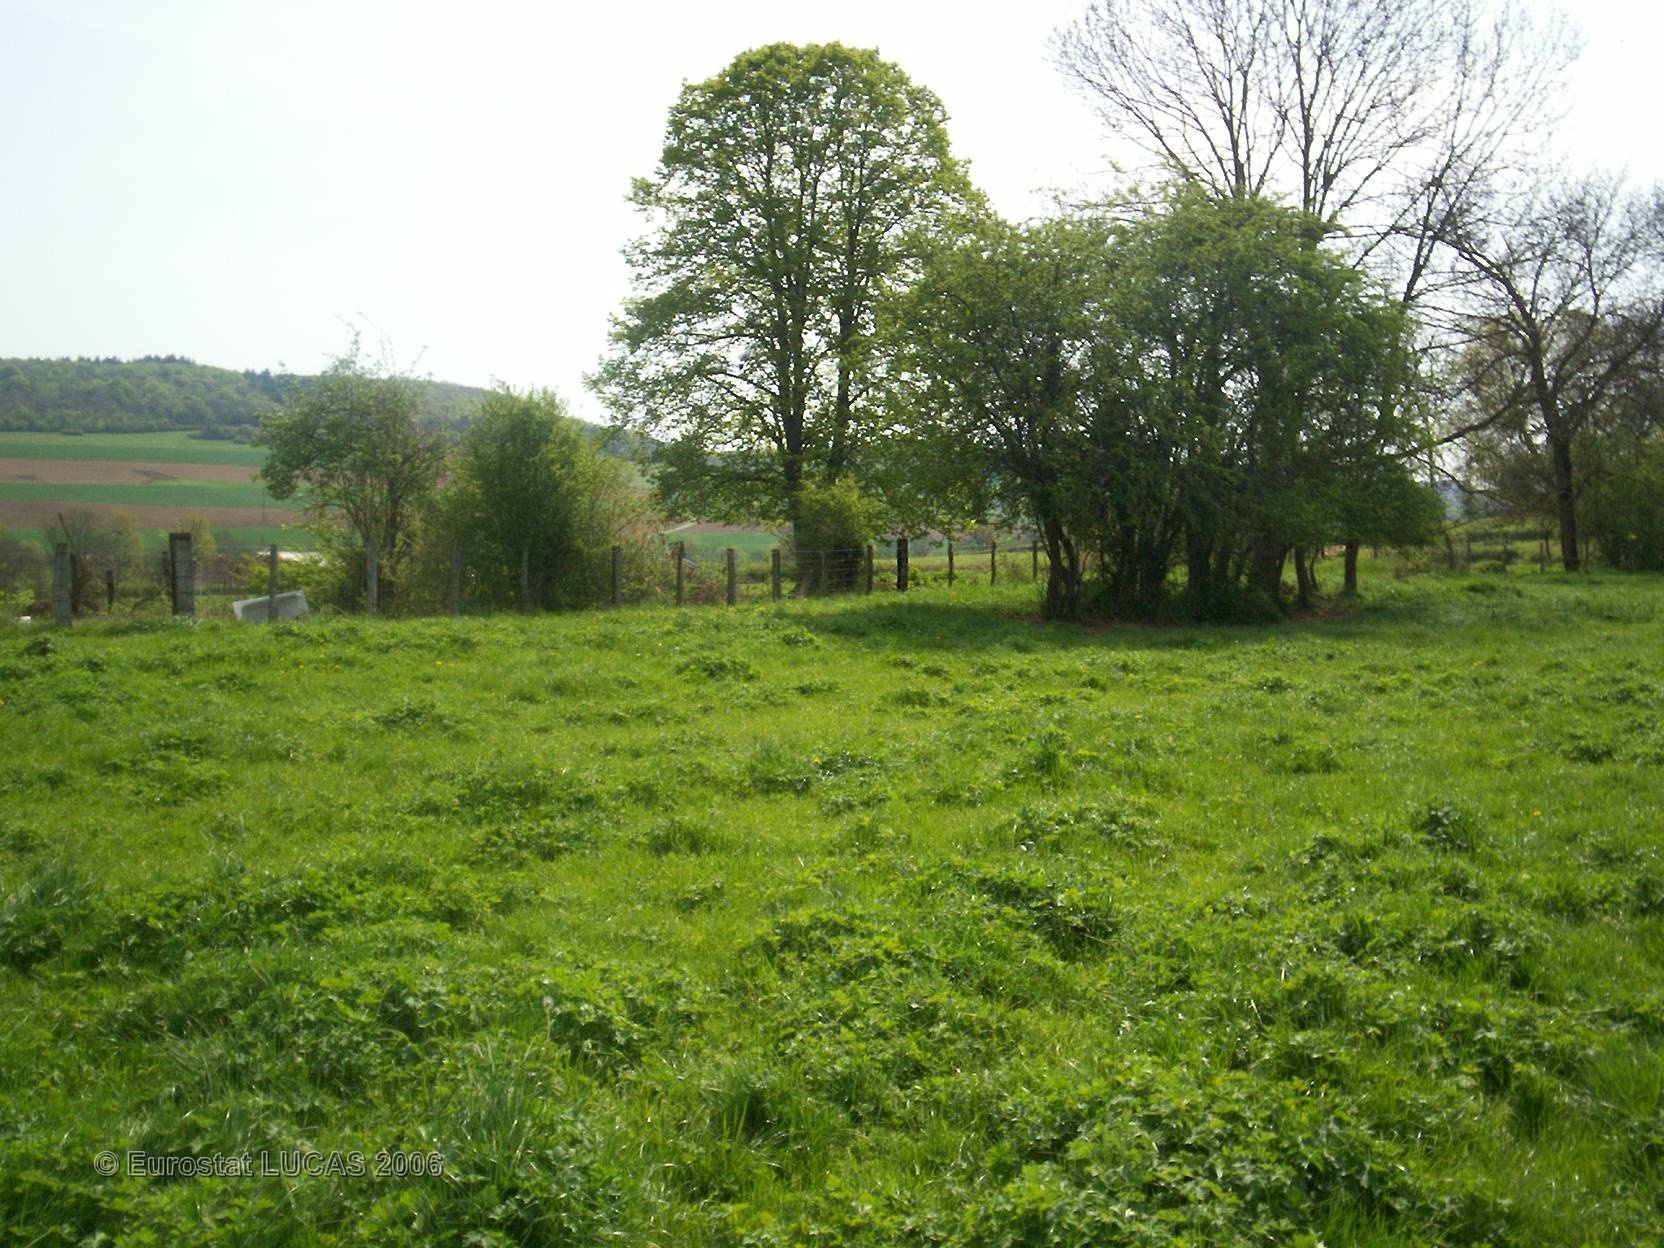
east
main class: Grassland
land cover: Grassland without tree/shrub cover
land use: Agriculture (excluding fallow land and kitchen gardens)
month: May
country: FR
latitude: 47.4420
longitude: 4.6023
